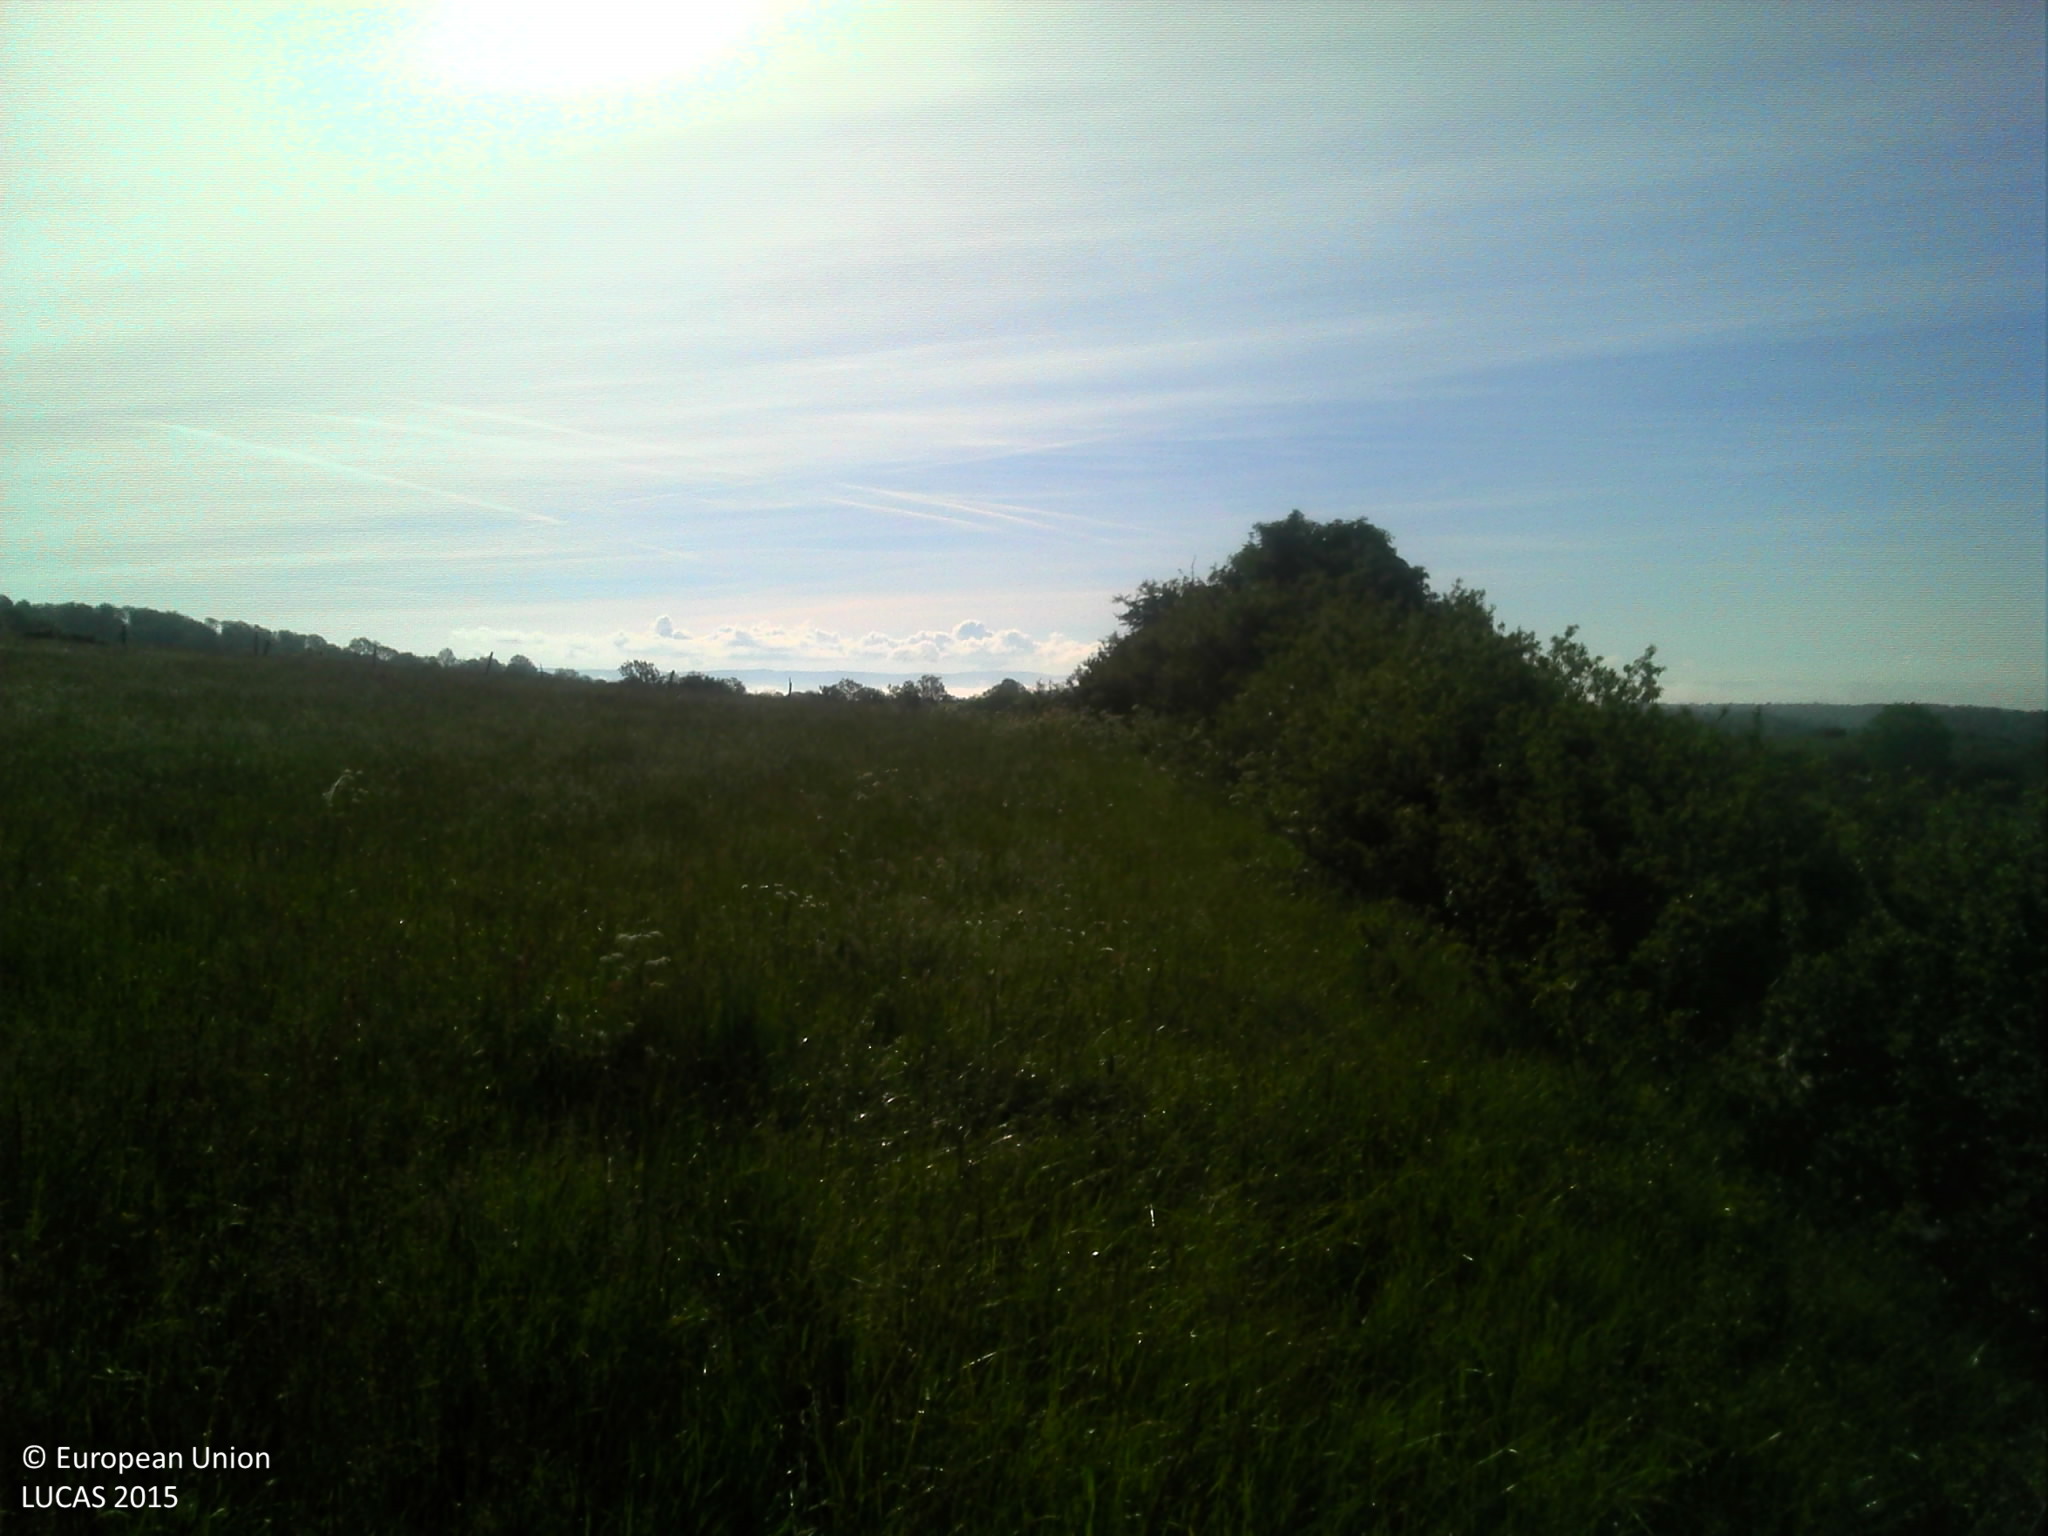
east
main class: Grassland
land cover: Grassland without tree/shrub cover
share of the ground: > 75 %
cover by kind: herbaceous plants 100 %
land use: Agriculture (excluding fallow land and kitchen gardens)
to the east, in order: Grassland without tree/shrub cover; Fences; Grassland without tree/shrub cover; Single bushes/trees; Grassland without tree/shrub cover; Dry stone walls; Fences; Grassland without tree/shrub cover
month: May
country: FR
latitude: 45.0177
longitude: 2.9846
